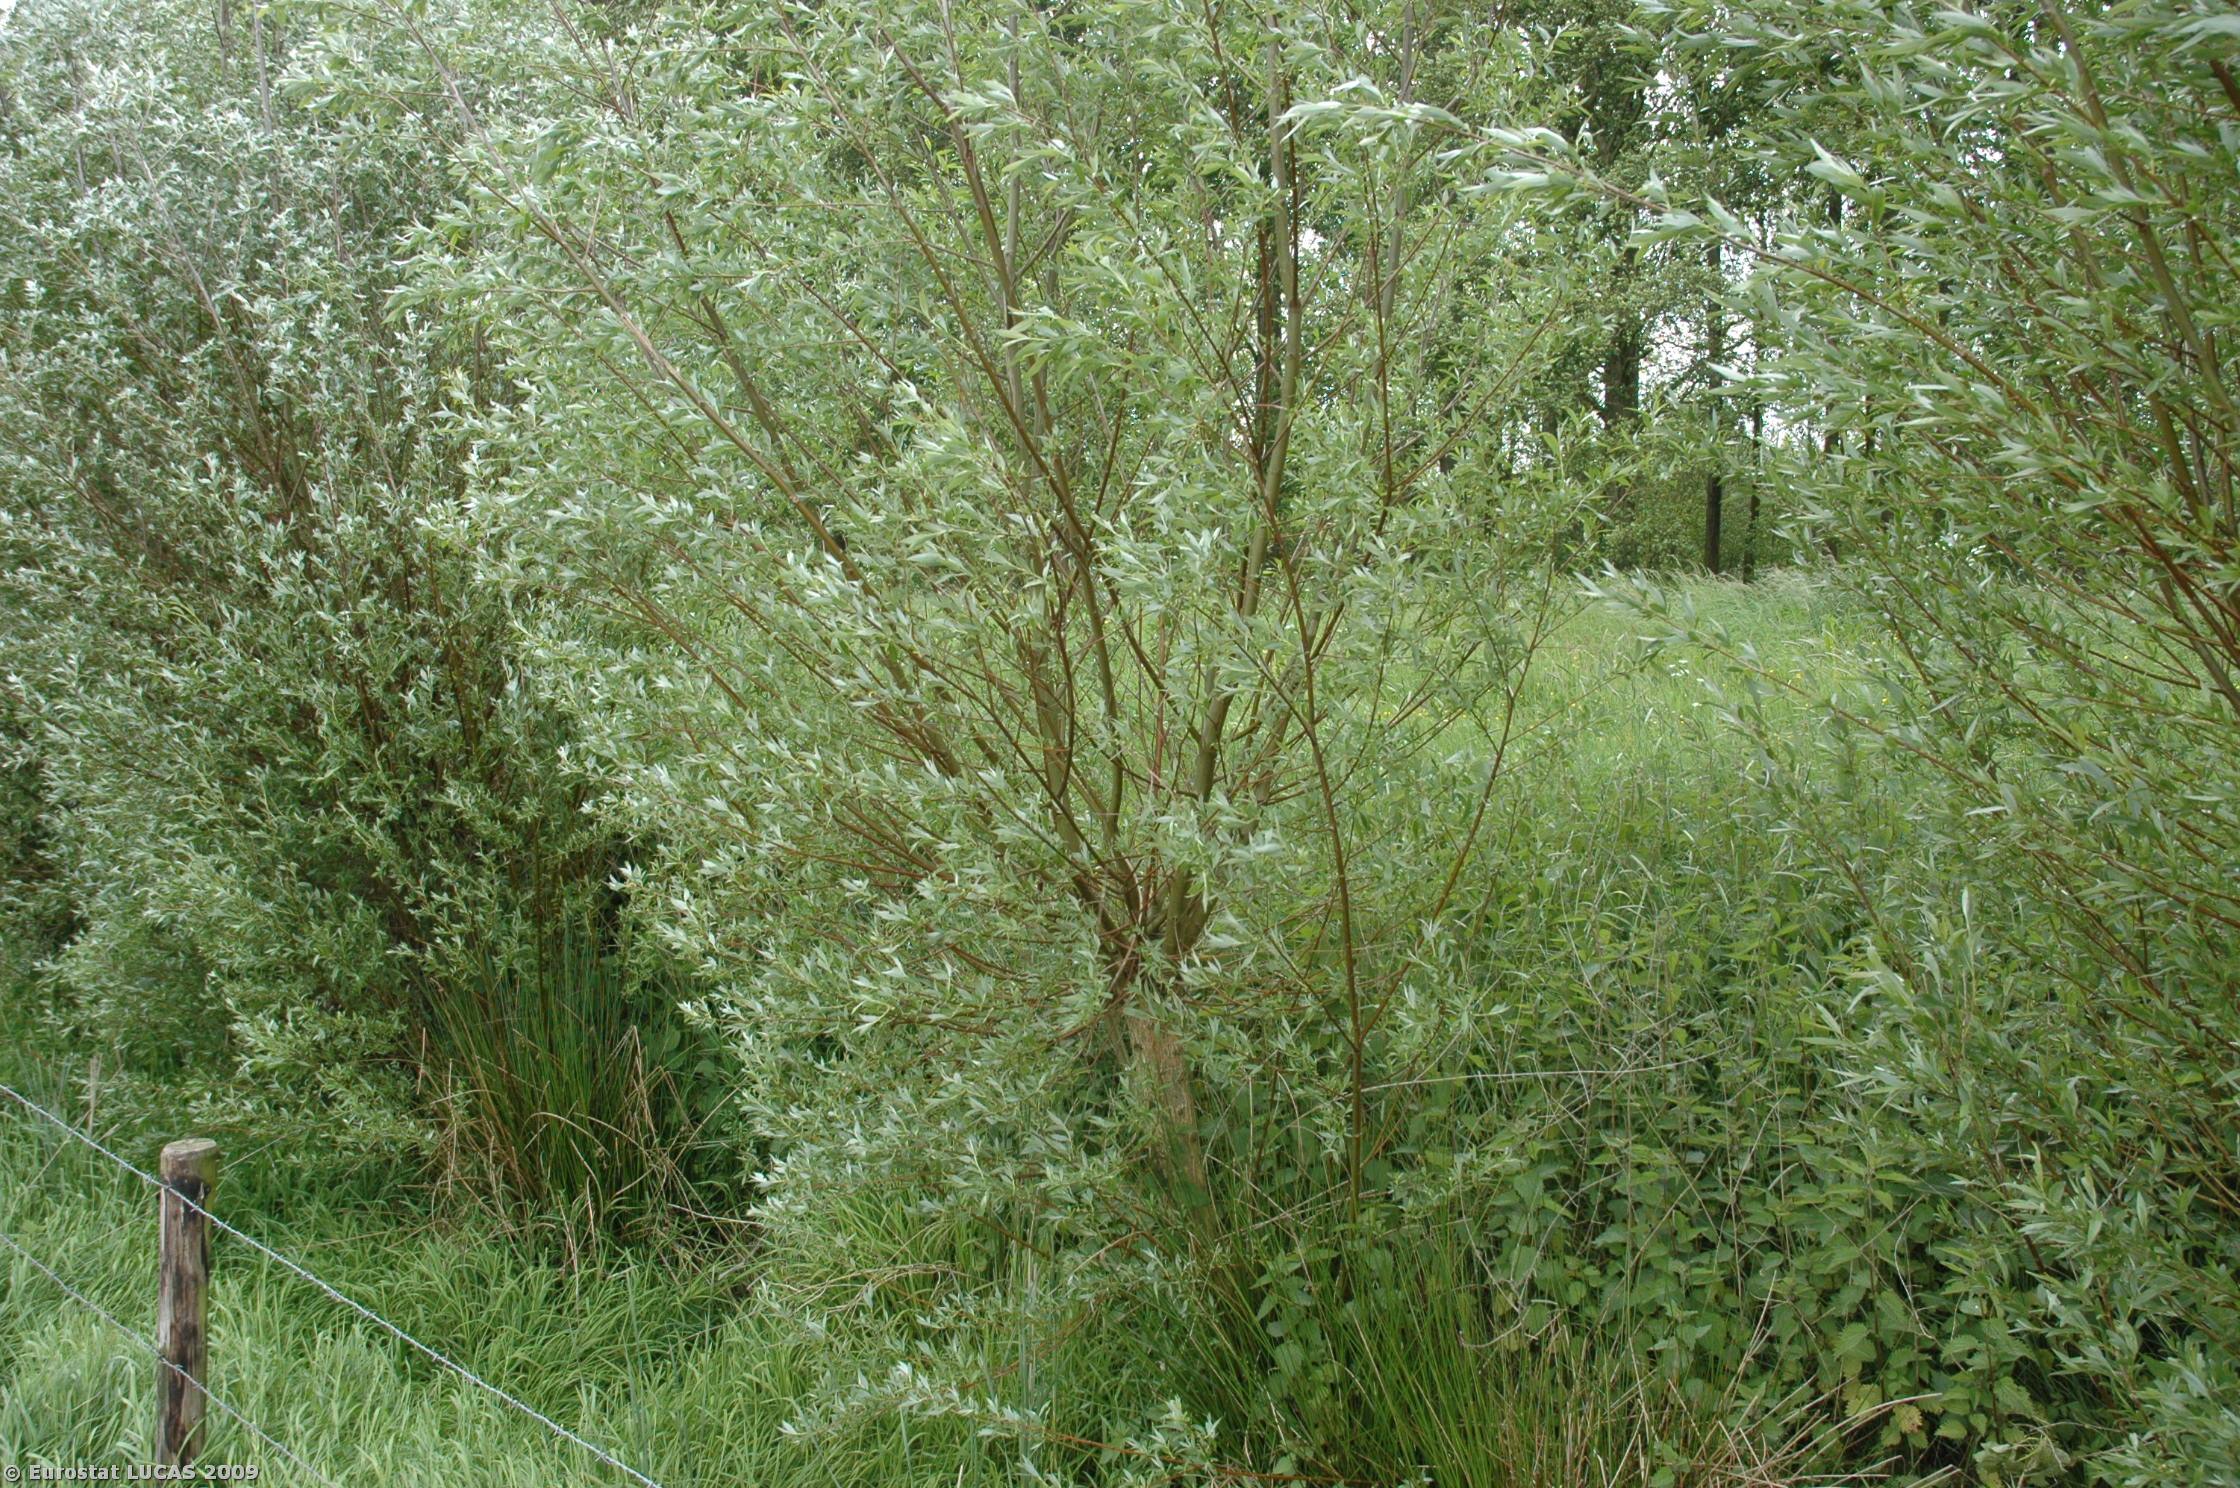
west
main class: Grassland
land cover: Grassland without tree/shrub cover
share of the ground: > 75 %
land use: Unused
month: May
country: NL
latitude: 51.9984
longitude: 5.3517
